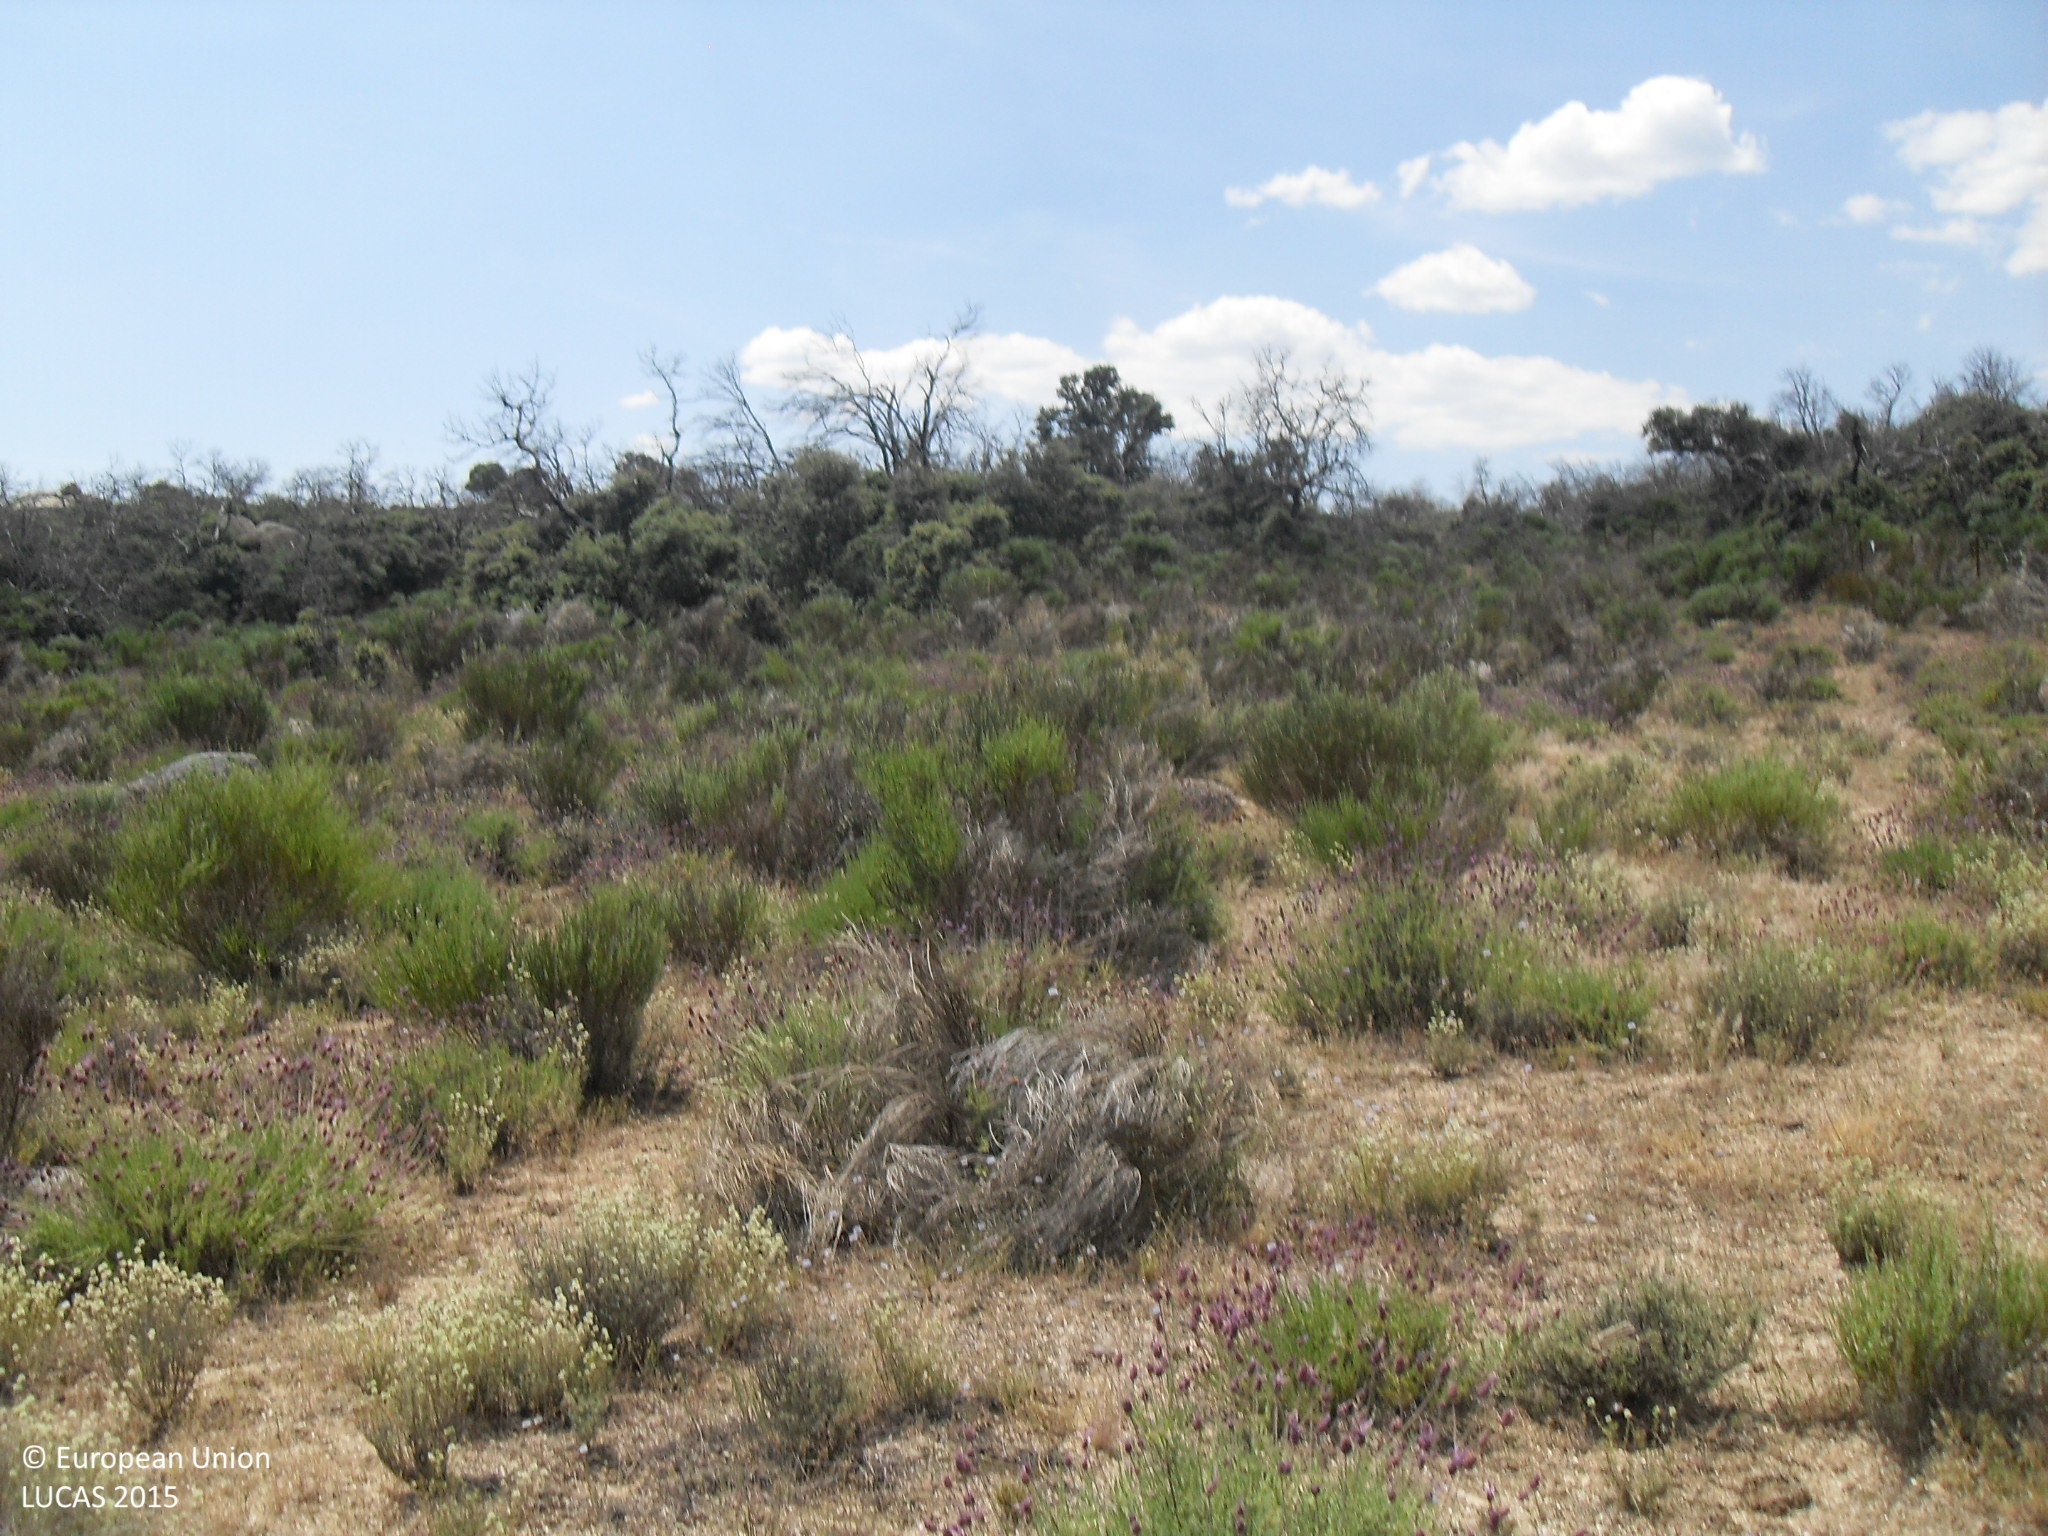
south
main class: Shrubland
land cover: Shrubland without tree cover
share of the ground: > 75 %
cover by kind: shrubs 60 %, herbaceous plants 40 %
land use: Abandoned areas
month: June
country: ES
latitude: 40.4491
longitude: -5.5729
